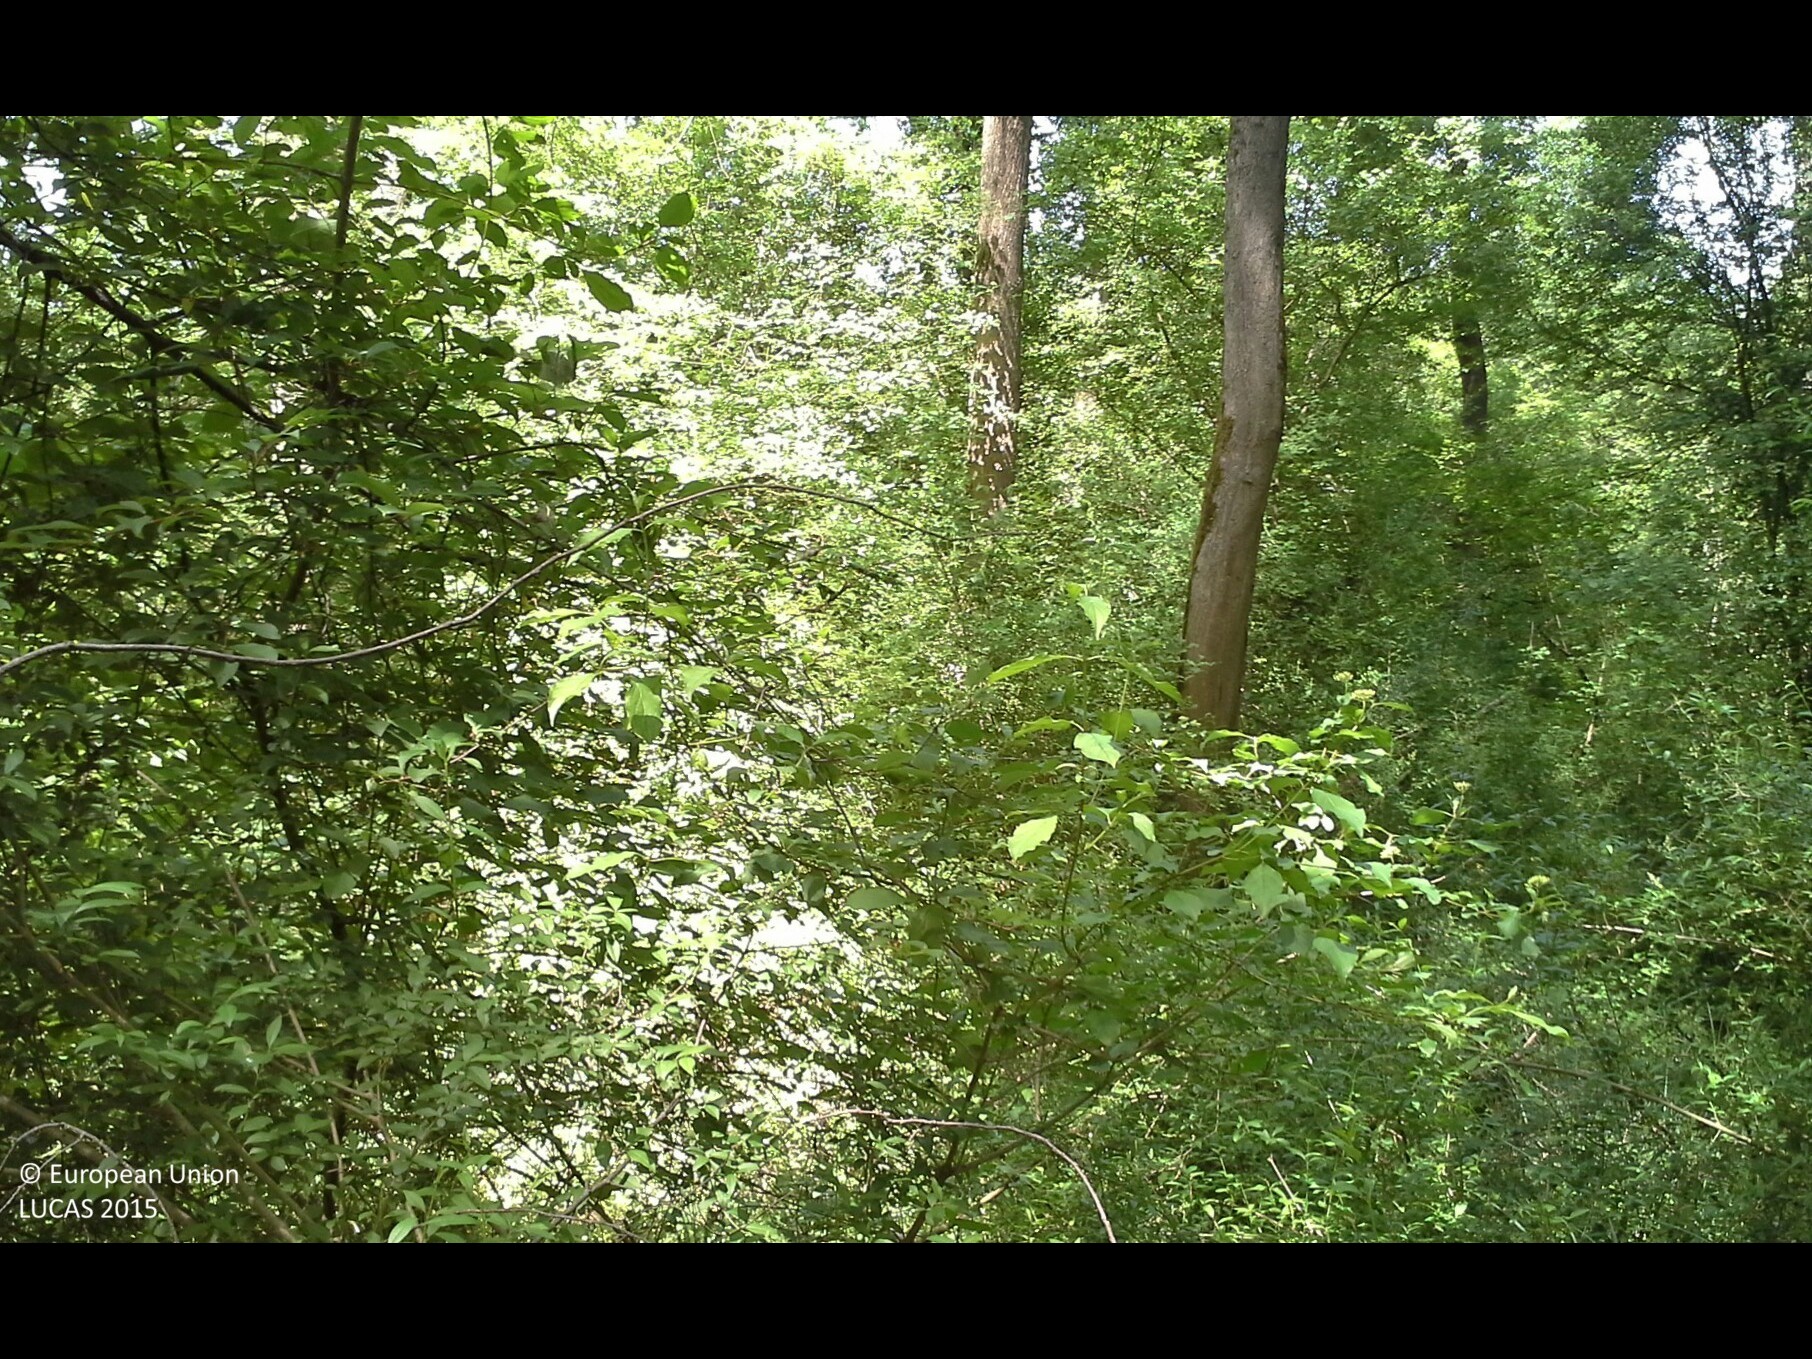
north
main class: Woodland
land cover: Broadleaved woodland
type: floodplain forest
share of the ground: > 75 %
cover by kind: broadleaved forest trees 80 %, shrubs 10 %, herbaceous plants 10 %
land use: Forestry
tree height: > 5 m
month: May
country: AT
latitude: 48.2638
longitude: 14.3514
